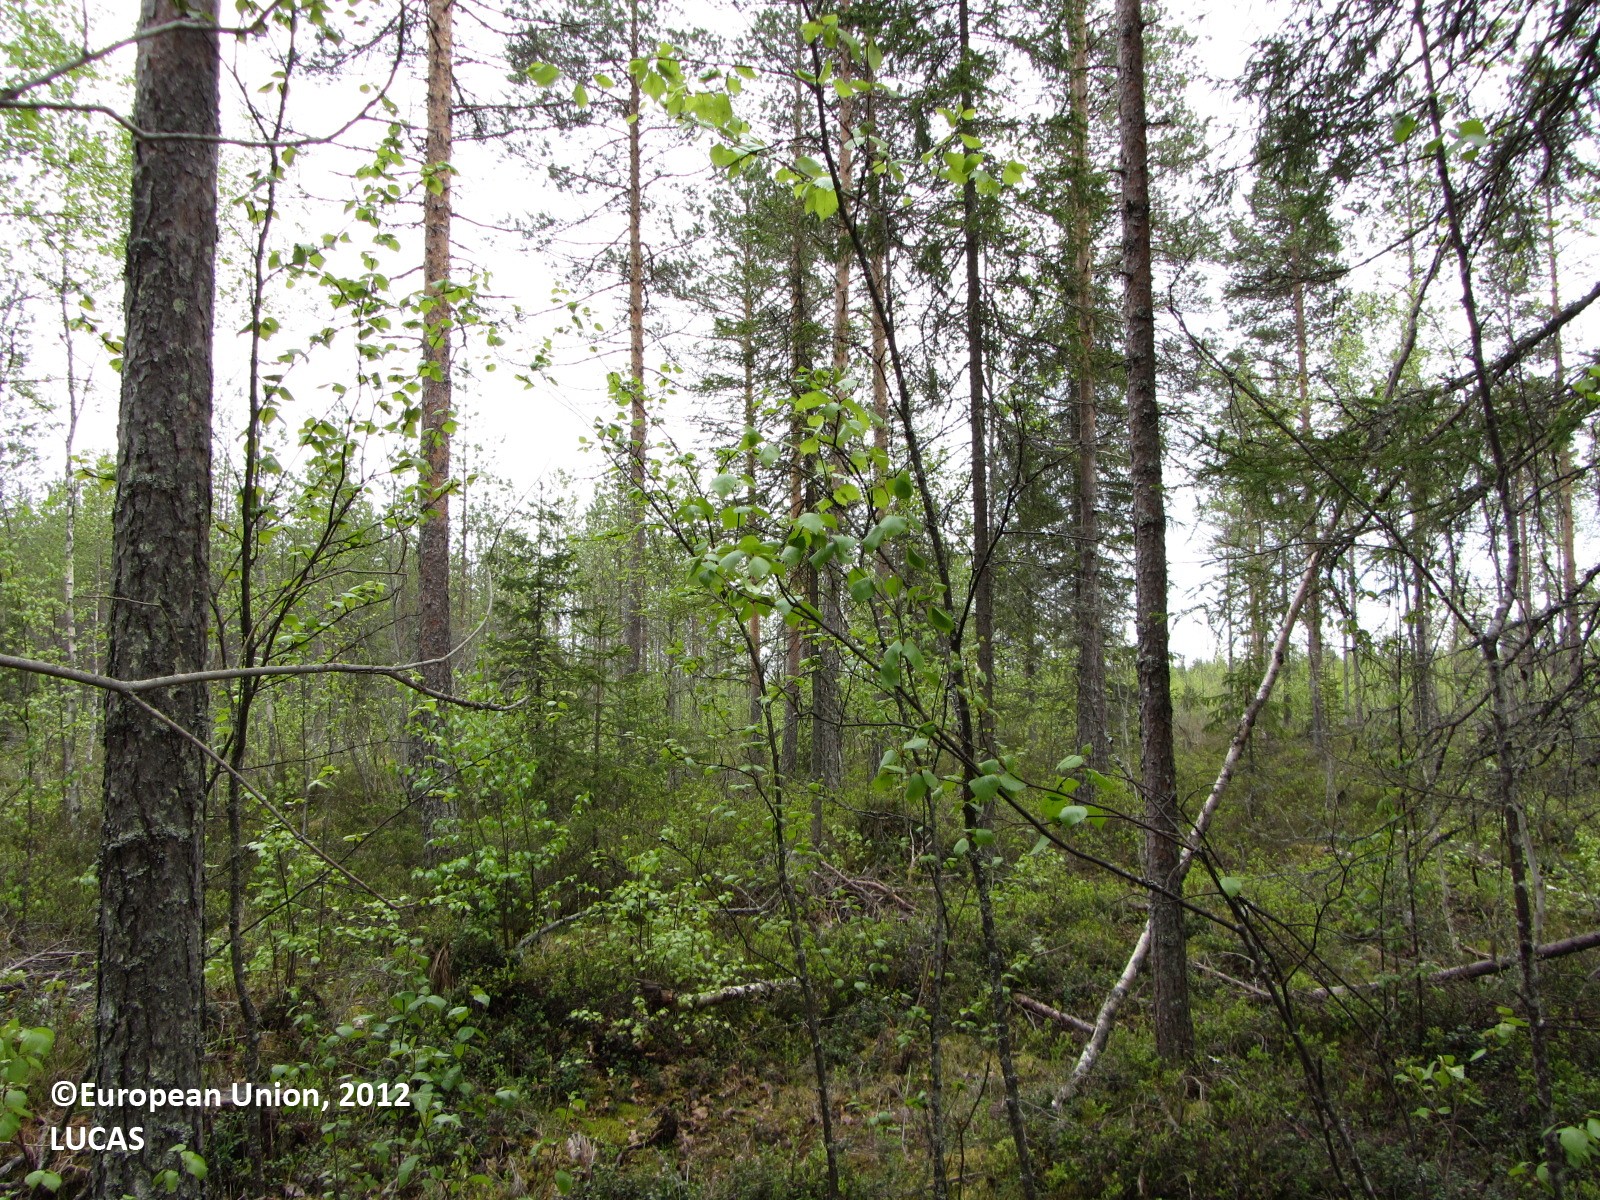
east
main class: Woodland
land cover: Pine dominated mixed woodland
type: boreal forest
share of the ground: > 75 %
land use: Forestry
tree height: > 5 m
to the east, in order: Pine dominated mixed woodland; Tracks; Pine dominated mixed woodland; Pine dominated coniferous woodland; Pine dominated mixed woodland; Rock outcrops; Shrubland with sparse tree cover; Broadleaved woodland
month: June
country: FI
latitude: 63.8378
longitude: 24.6962
